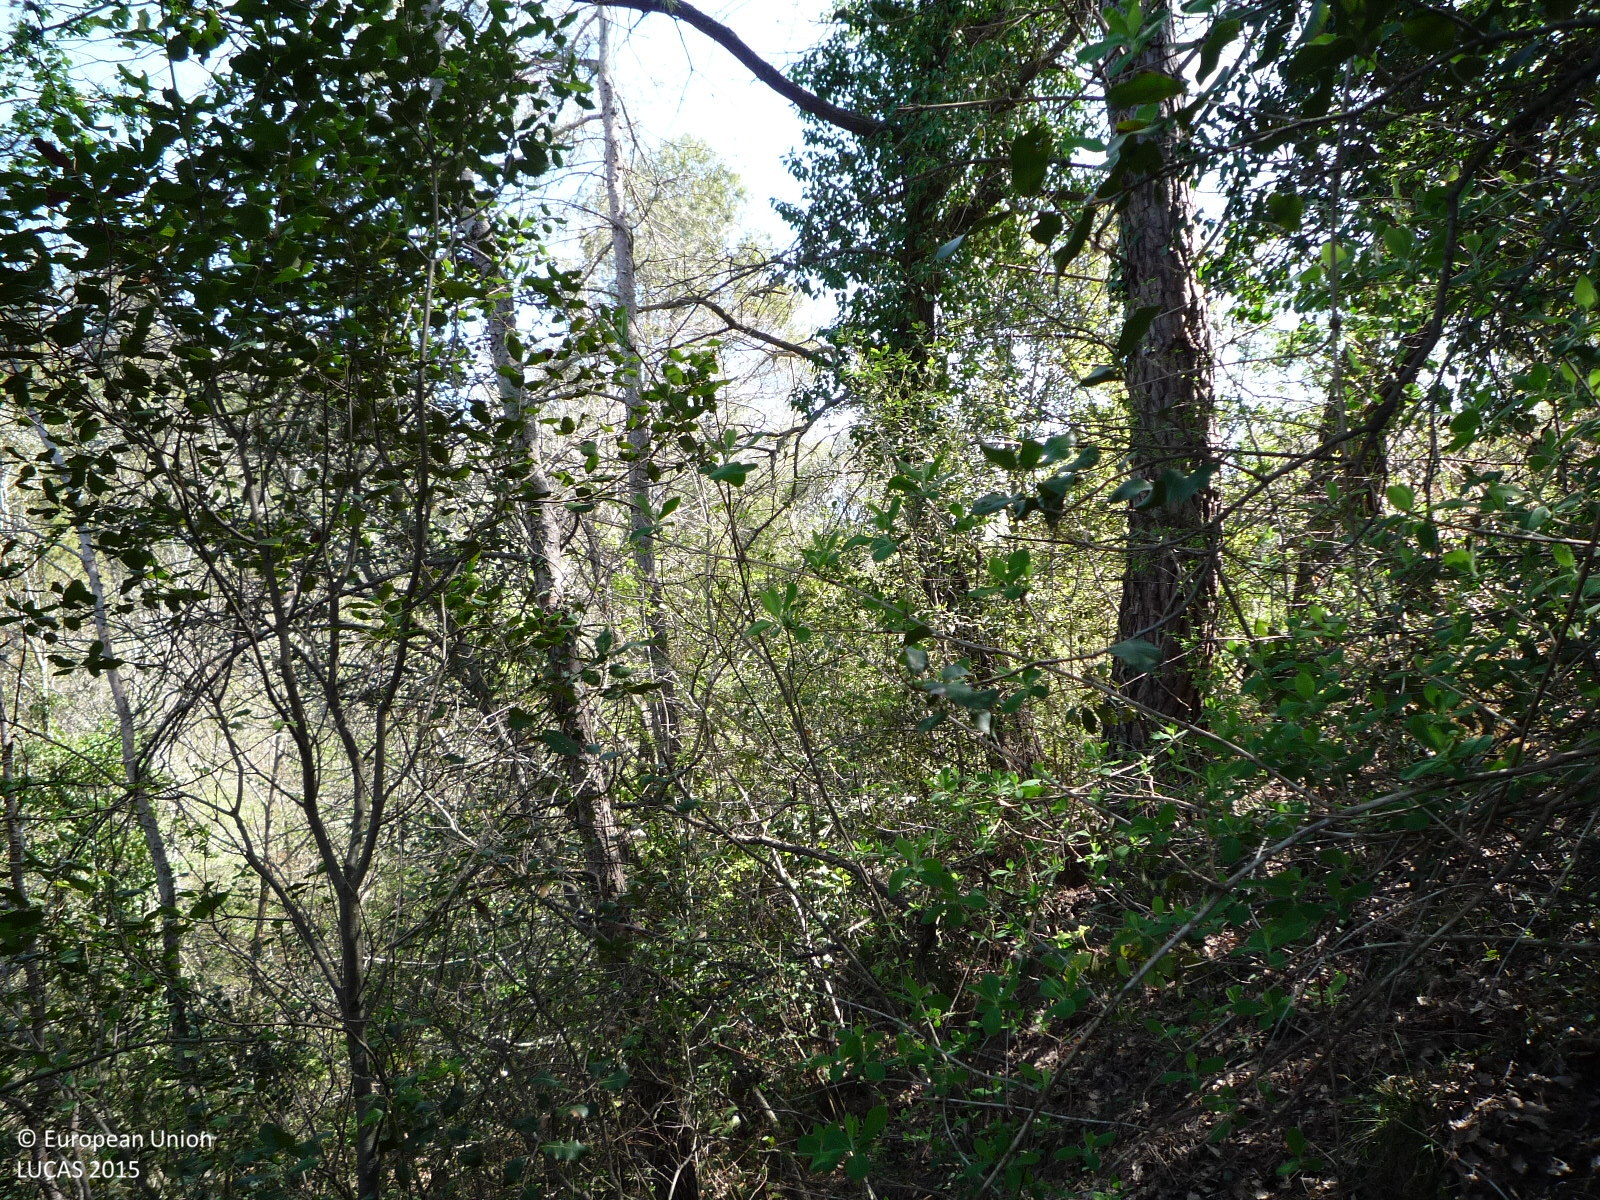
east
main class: Woodland
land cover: Pine dominated mixed woodland
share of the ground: > 75 %
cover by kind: coniferous forest trees 55 %, broadleaved forest trees 45 %
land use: Semi-natural and natural areas not in use
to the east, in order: Pine dominated mixed woodland; Shrubland with sparse tree cover; Tracks; Pine dominated coniferous woodland; Barley; Shruby margins; Dry stone walls; Pine dominated coniferous woodland; Tracks; Pine dominated mixed woodland
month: April
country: ES
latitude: 41.5292
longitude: 1.6626
